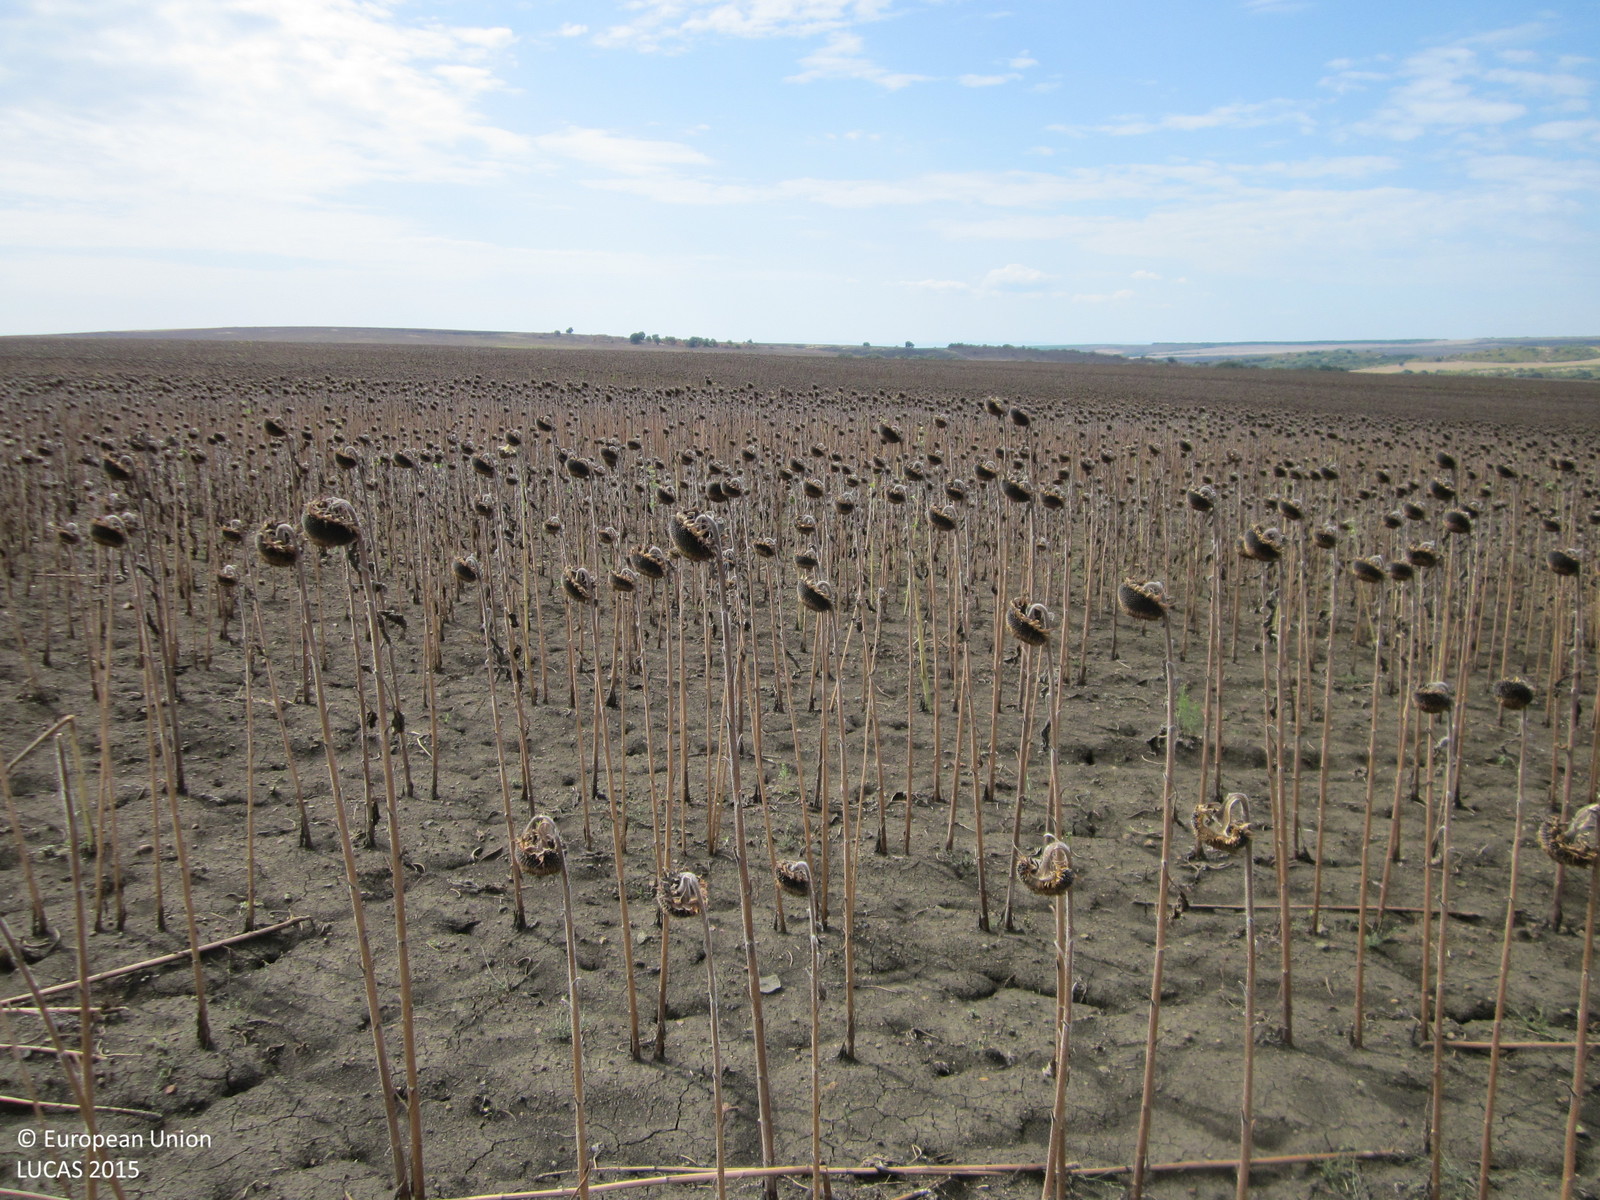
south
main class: Cropland
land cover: Sunflower
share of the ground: 50 - 75 %
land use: Agriculture (excluding fallow land and kitchen gardens)
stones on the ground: < 10 %
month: August
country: BG
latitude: 42.5857
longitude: 27.1068
